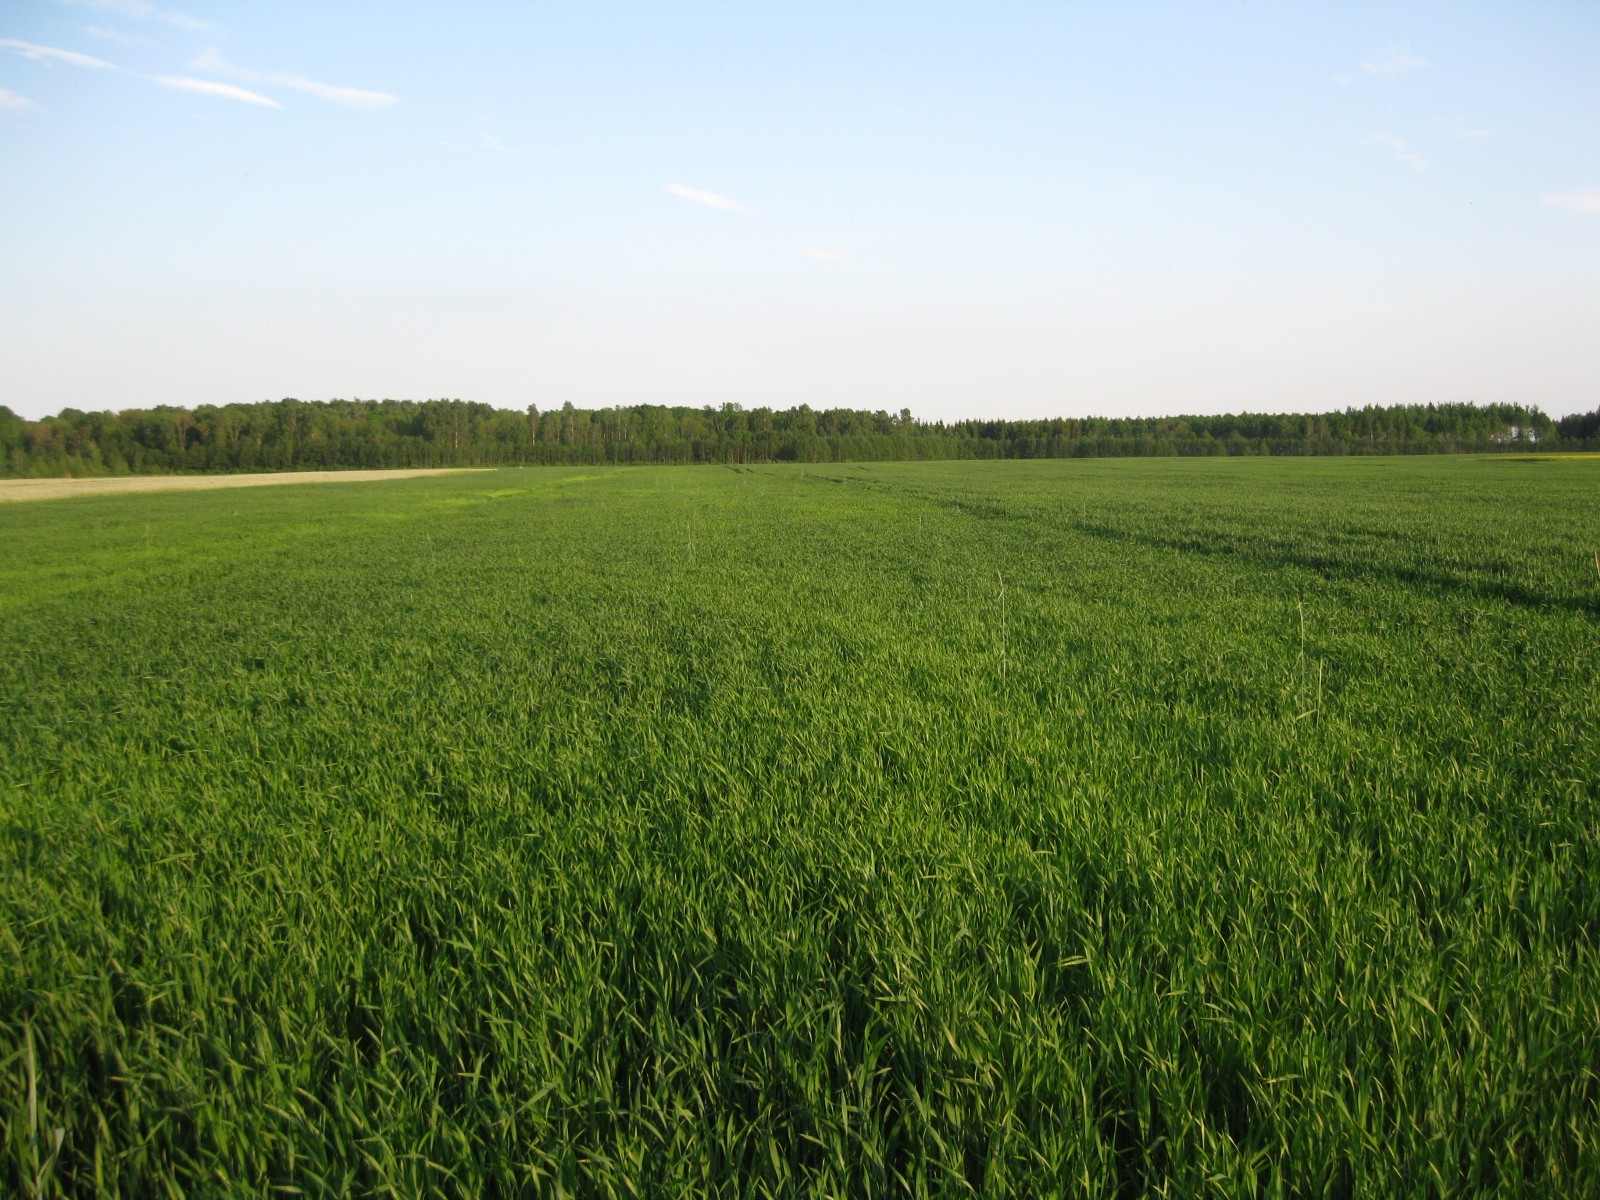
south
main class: Cropland
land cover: Common wheat
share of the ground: > 75 %
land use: Agriculture (excluding fallow land and kitchen gardens)
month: June
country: LT
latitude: 55.8466
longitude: 24.0642
